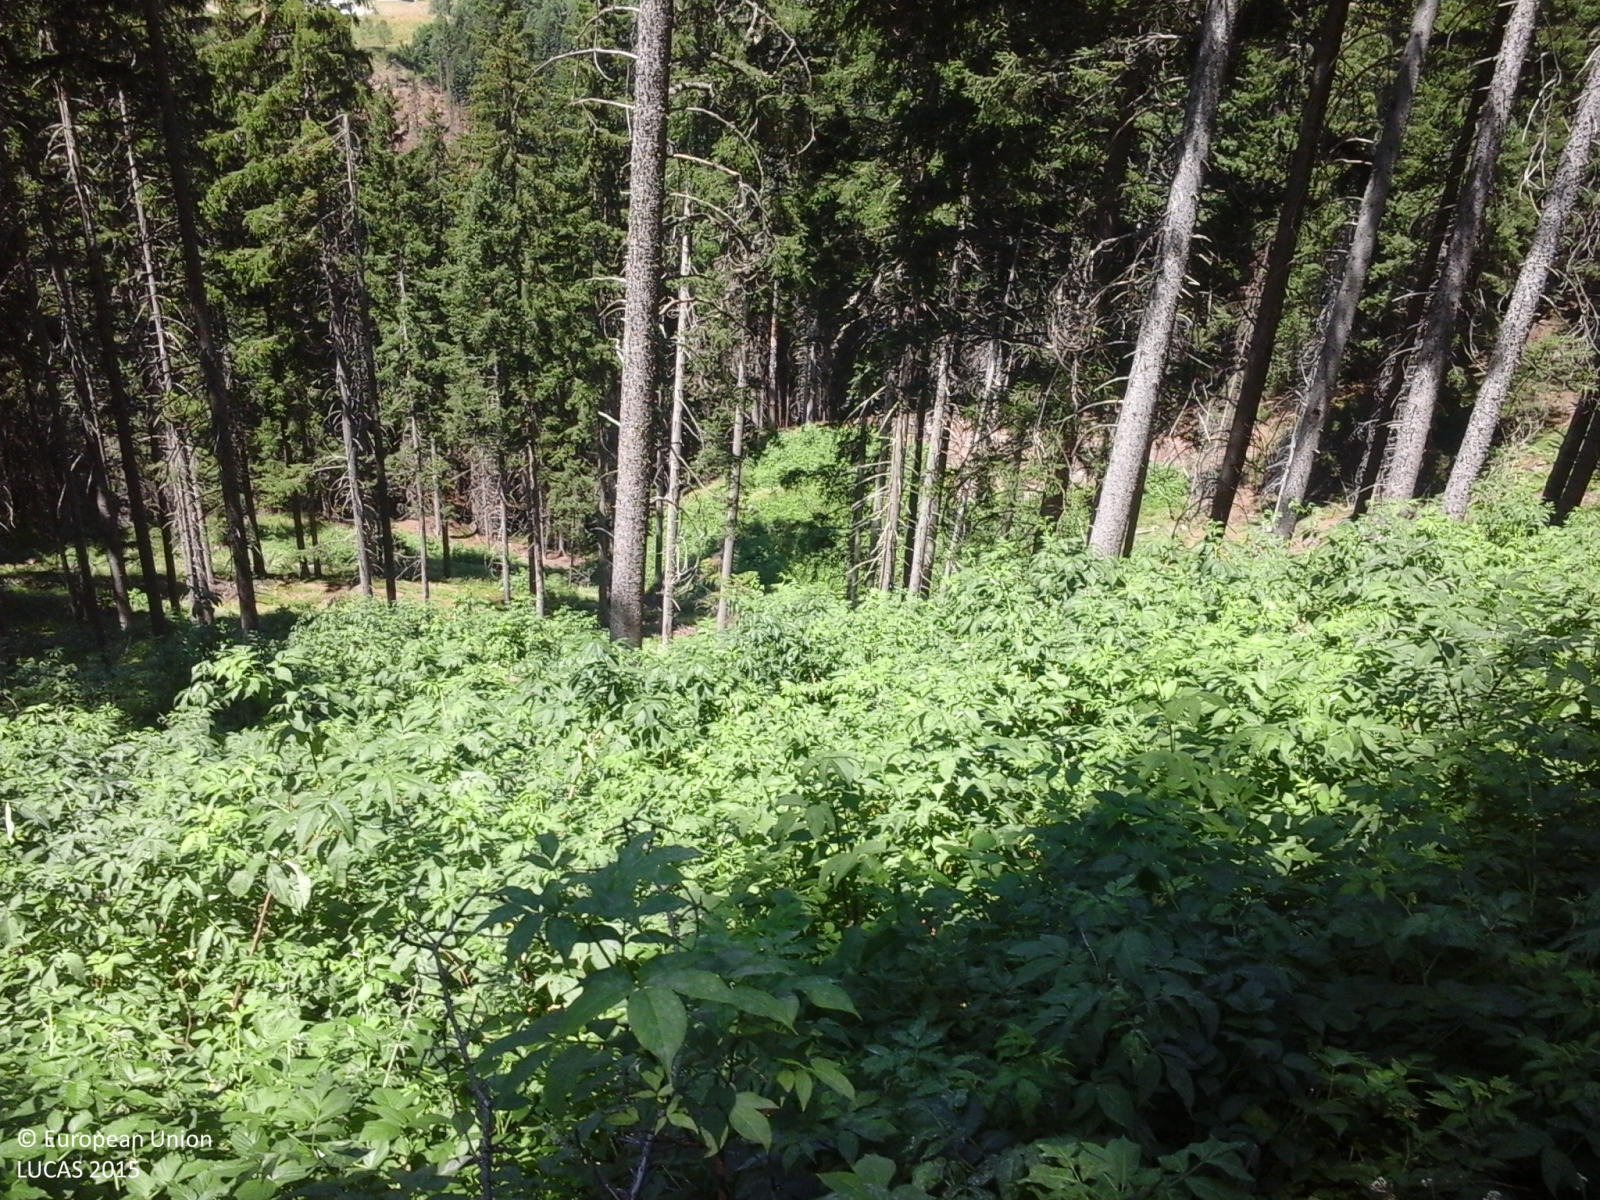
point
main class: Woodland
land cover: Spruce dominated coniferous woodland
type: alpine coniferous forest
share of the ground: > 75 %
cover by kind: coniferous forest trees 100 %
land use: Forestry
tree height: > 5 m
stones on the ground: 10 - 25 %
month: July
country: IT
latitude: 46.4769
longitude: 10.2732
